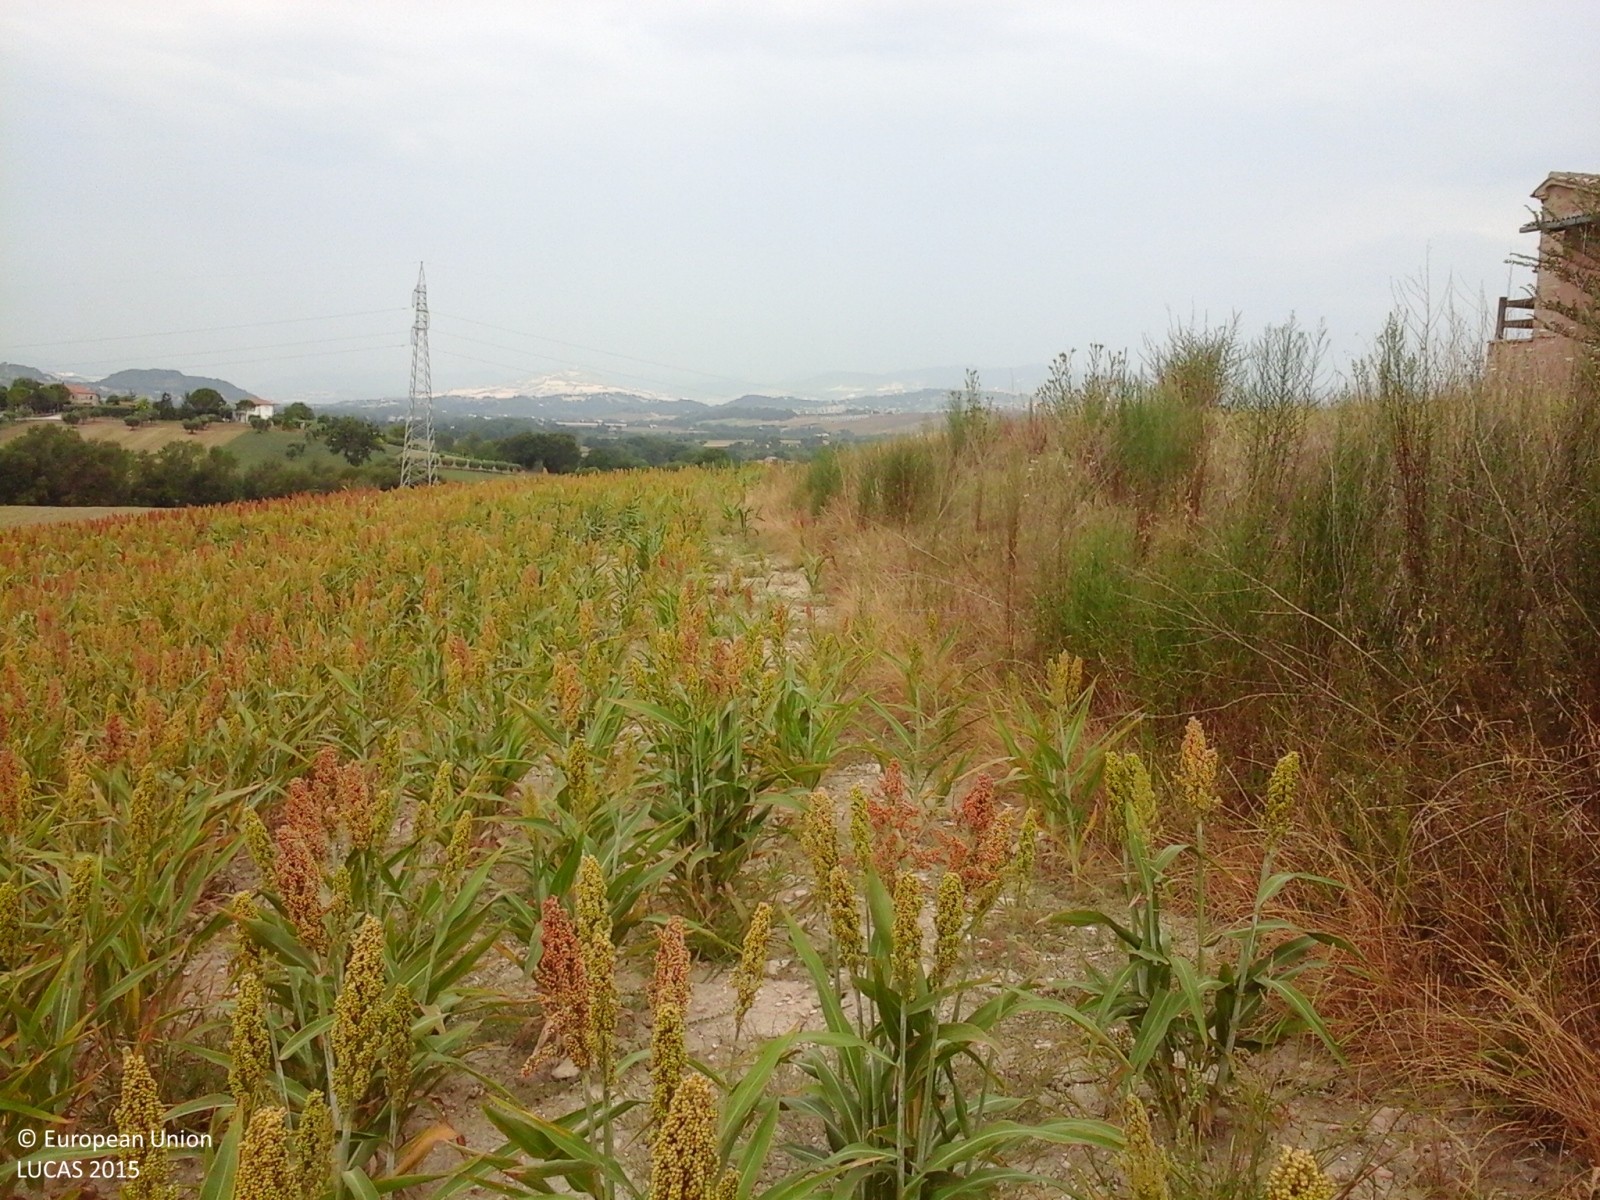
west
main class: Cropland
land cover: Other cereals
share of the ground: > 75 %
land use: Agriculture (excluding fallow land and kitchen gardens)
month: August
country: IT
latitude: 43.3015
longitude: 13.4059
